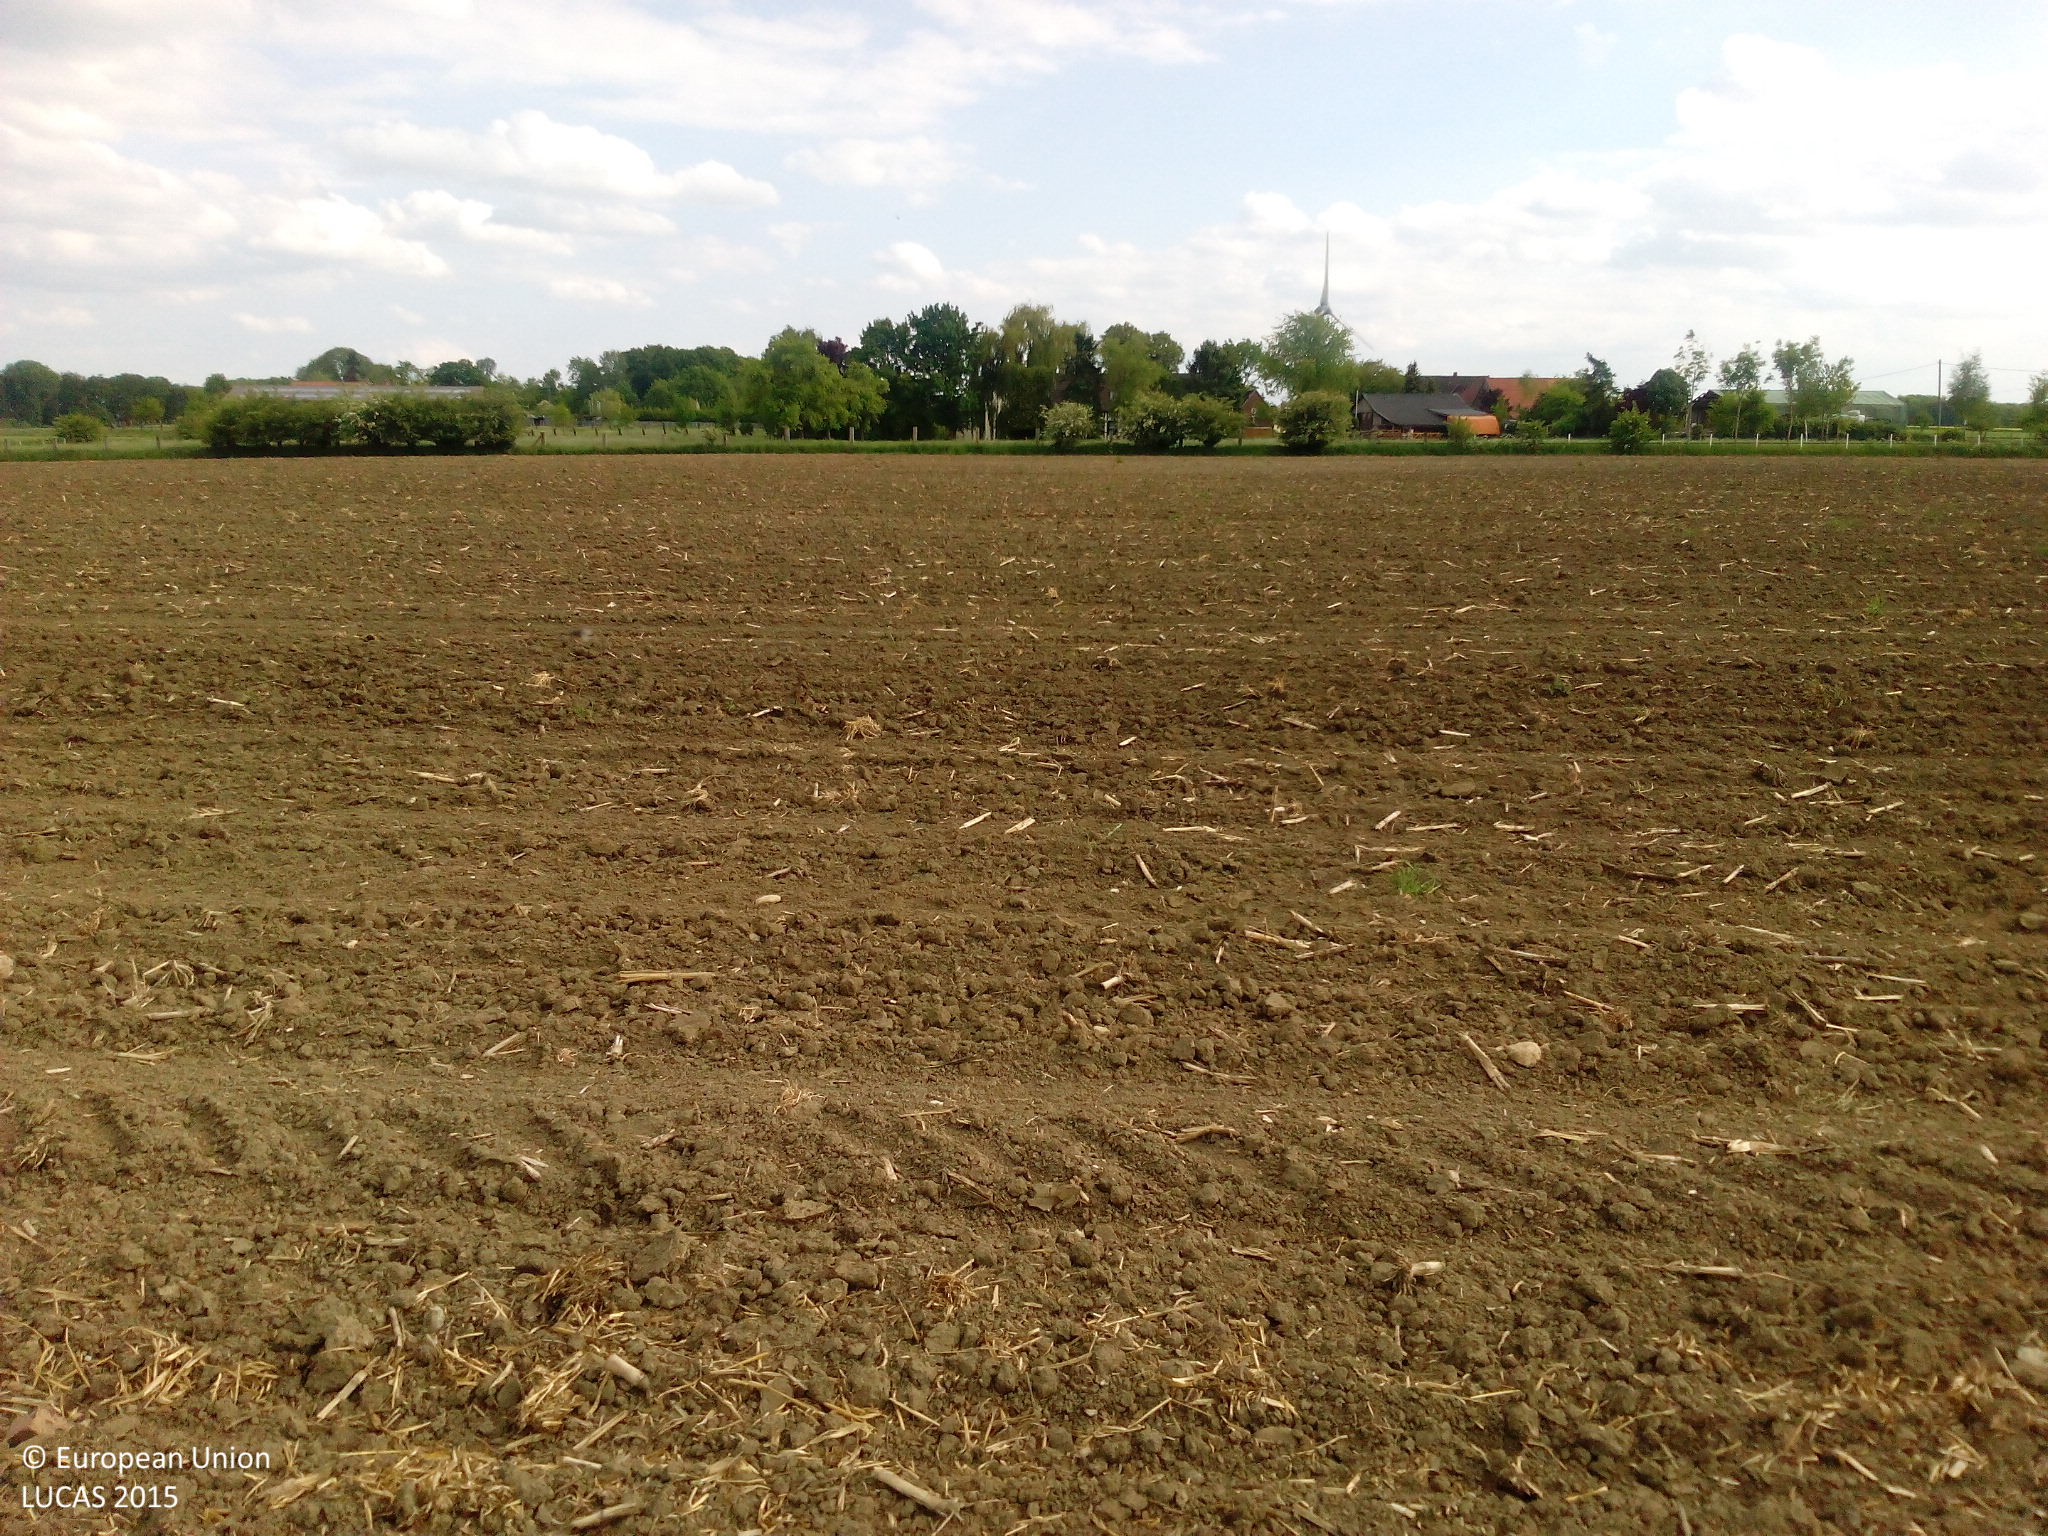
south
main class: Cropland
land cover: Maize
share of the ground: < 10 %
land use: Agriculture (excluding fallow land and kitchen gardens)
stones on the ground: < 10 %
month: May
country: DE
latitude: 51.7491
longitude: 7.9870
